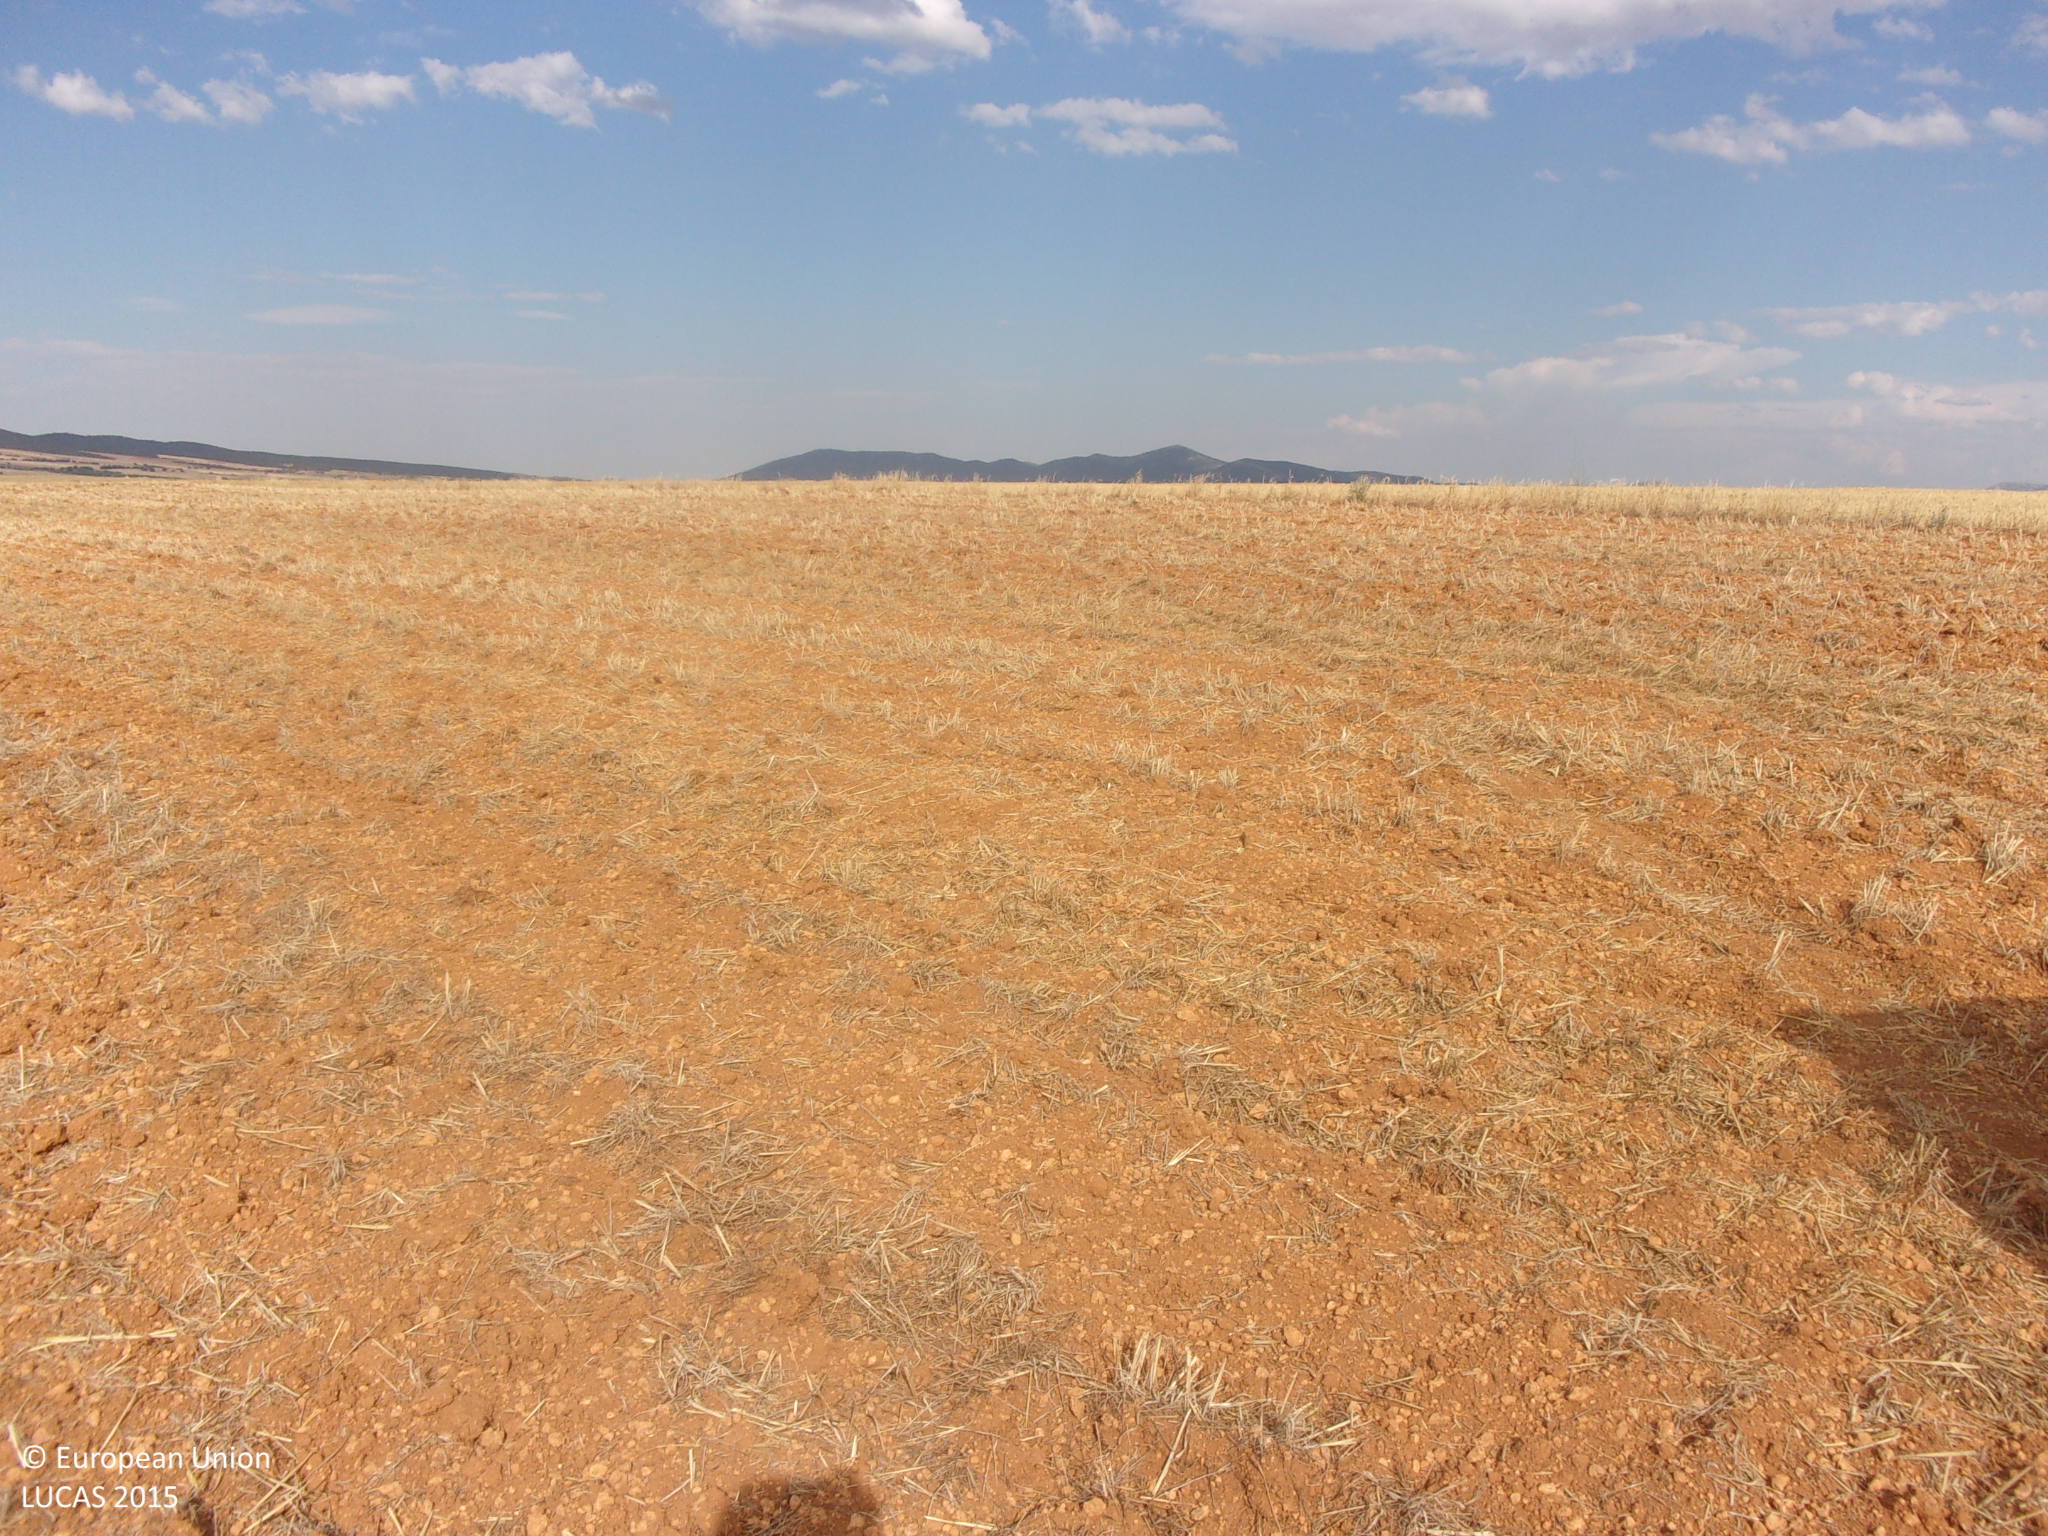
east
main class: Cropland
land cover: Barley
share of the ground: < 10 %
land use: Agriculture (excluding fallow land and kitchen gardens)
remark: Harvested field
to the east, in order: Barley; Grass margins; Barley; Grass margins; Tracks; Grass margins; Dry pulses; Grass margins; Tracks; Grass margins; Barley
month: July
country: ES
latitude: 41.2077
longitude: -1.3871
